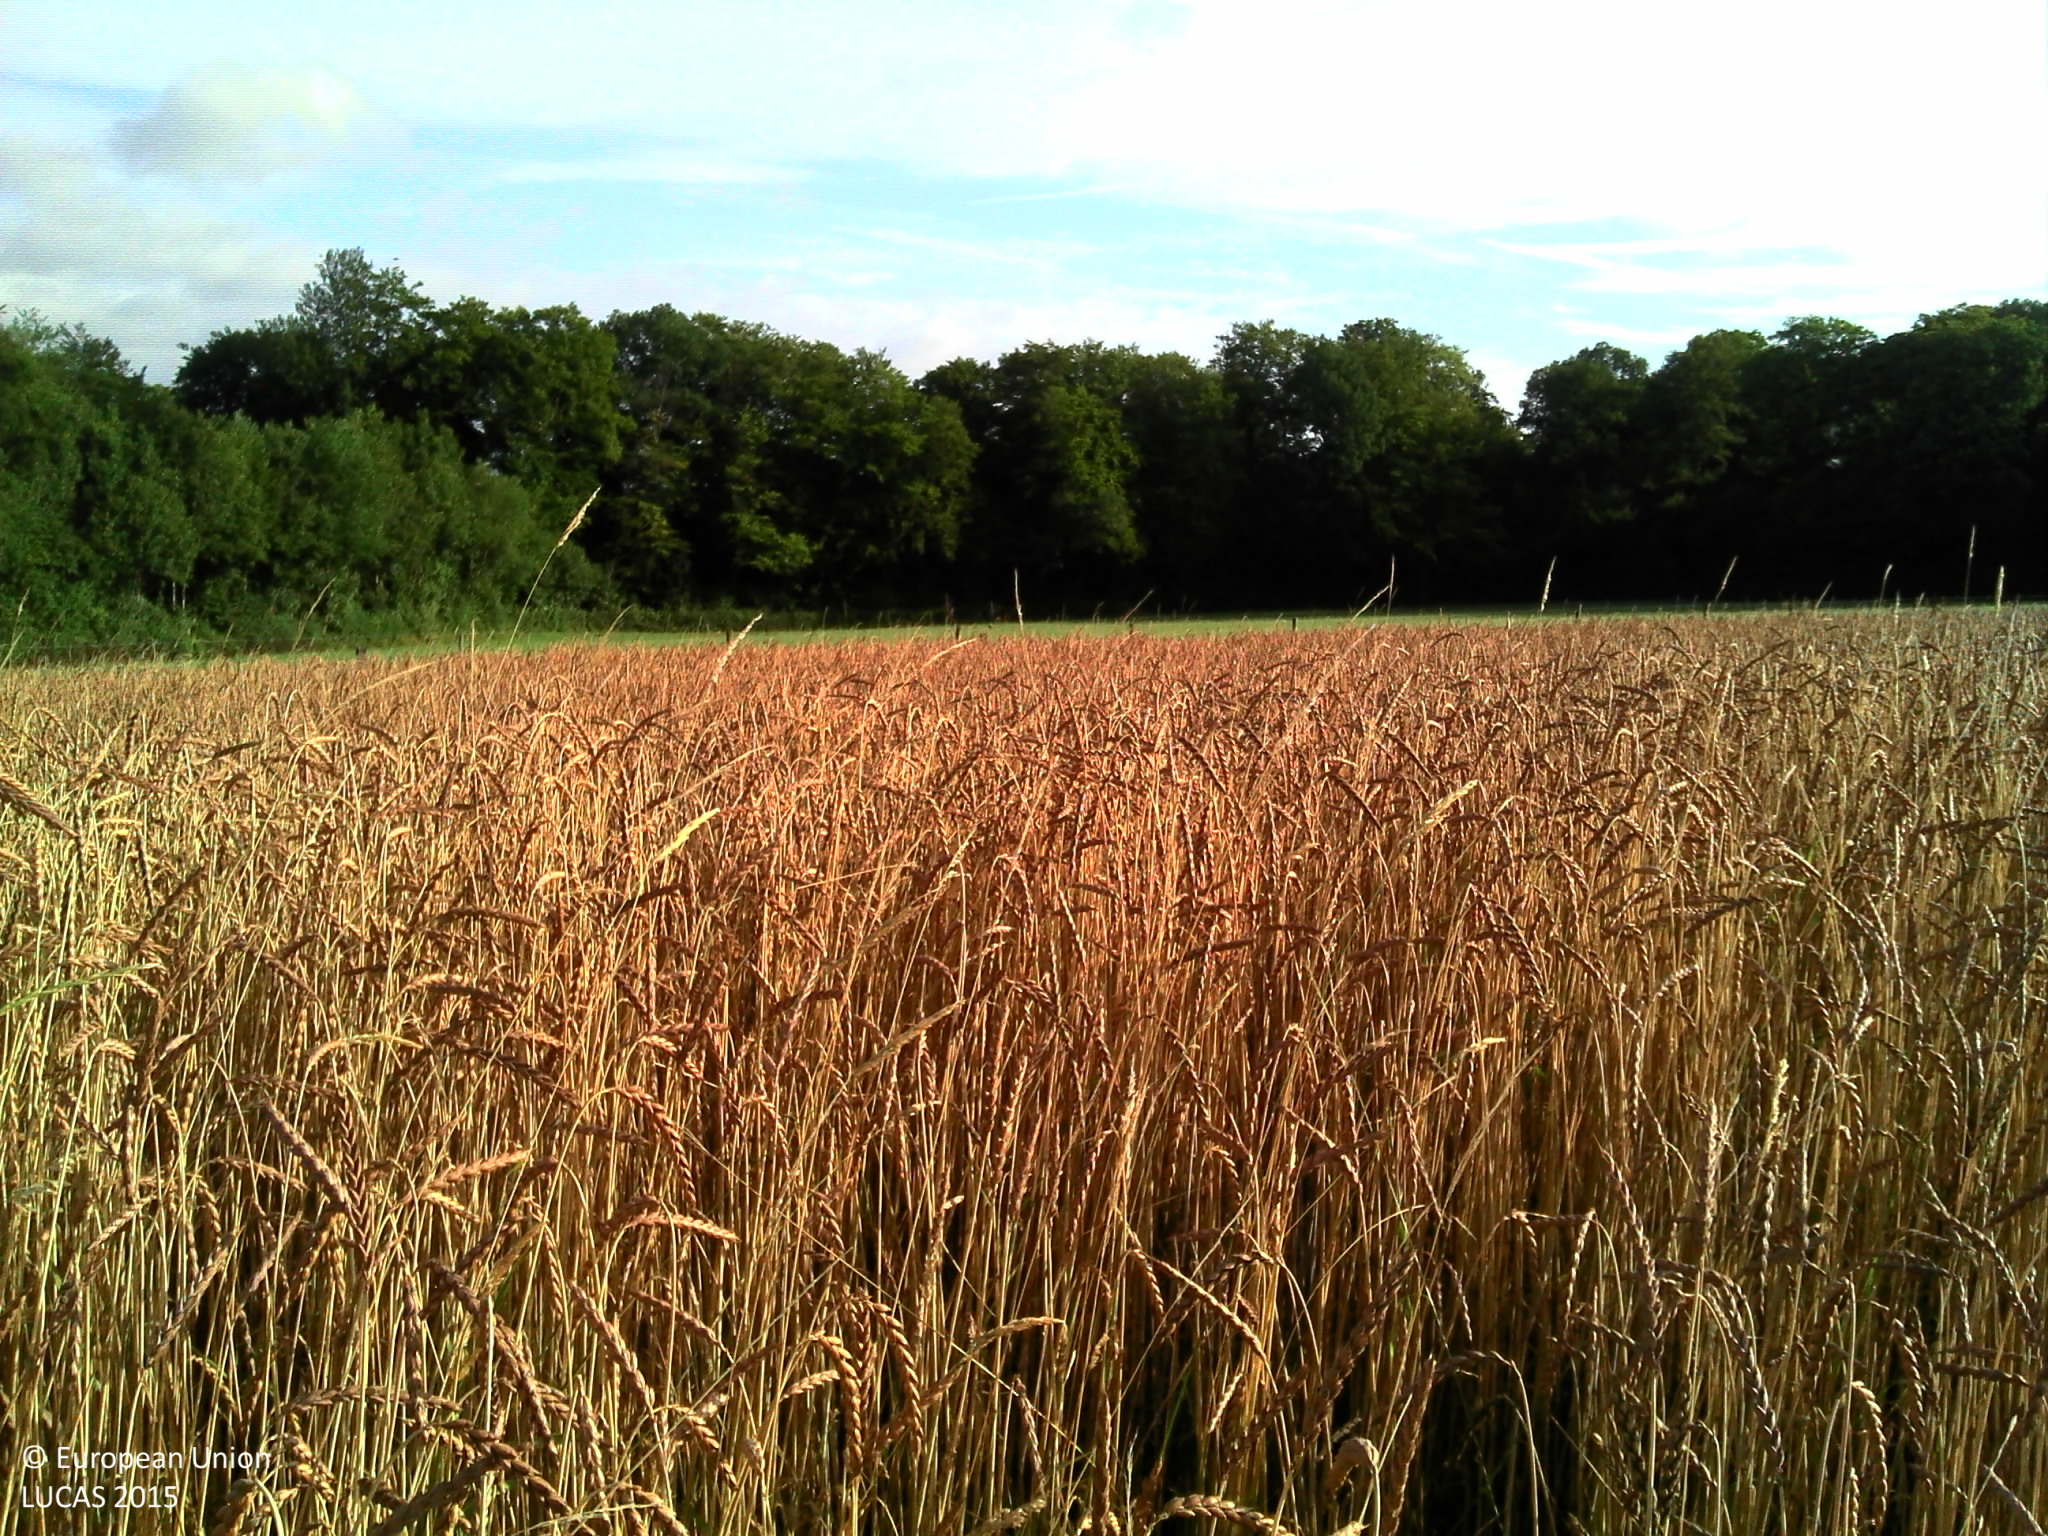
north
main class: Grassland
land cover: Grassland without tree/shrub cover
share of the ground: > 75 %
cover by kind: herbaceous plants 100 %
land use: Agriculture (excluding fallow land and kitchen gardens)
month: July
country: BE
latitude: 49.7117
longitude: 5.8247
